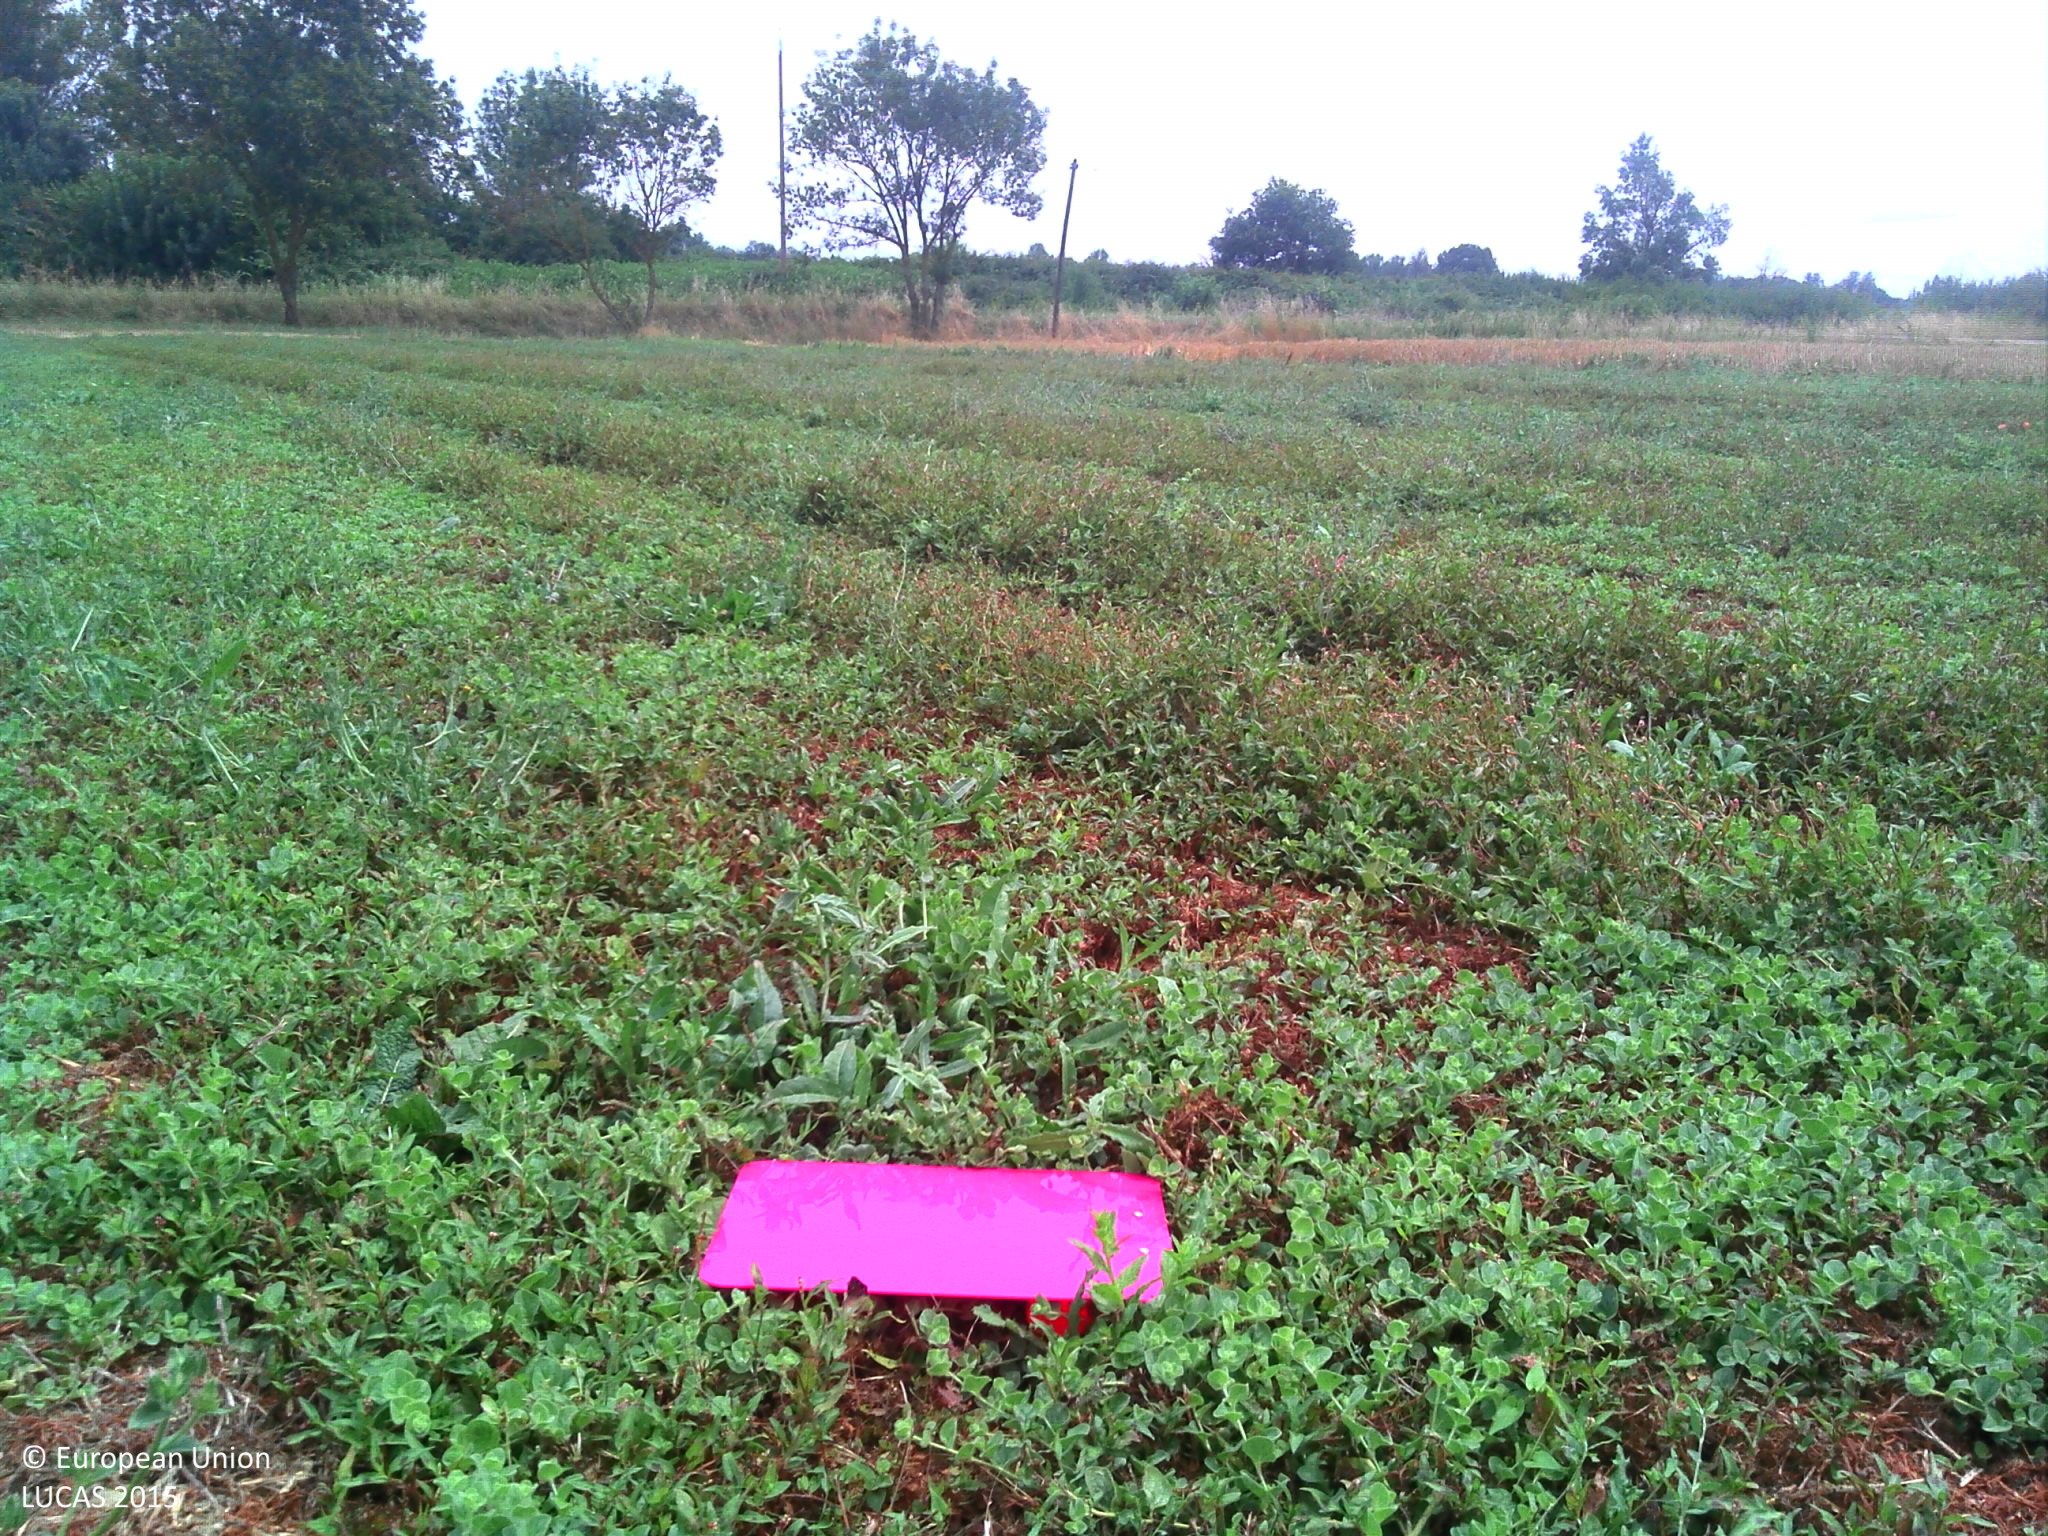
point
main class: Cropland
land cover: Temporary grasslands
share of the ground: > 75 %
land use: Agriculture (excluding fallow land and kitchen gardens)
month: July
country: FR
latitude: 43.8640
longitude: 0.9529
